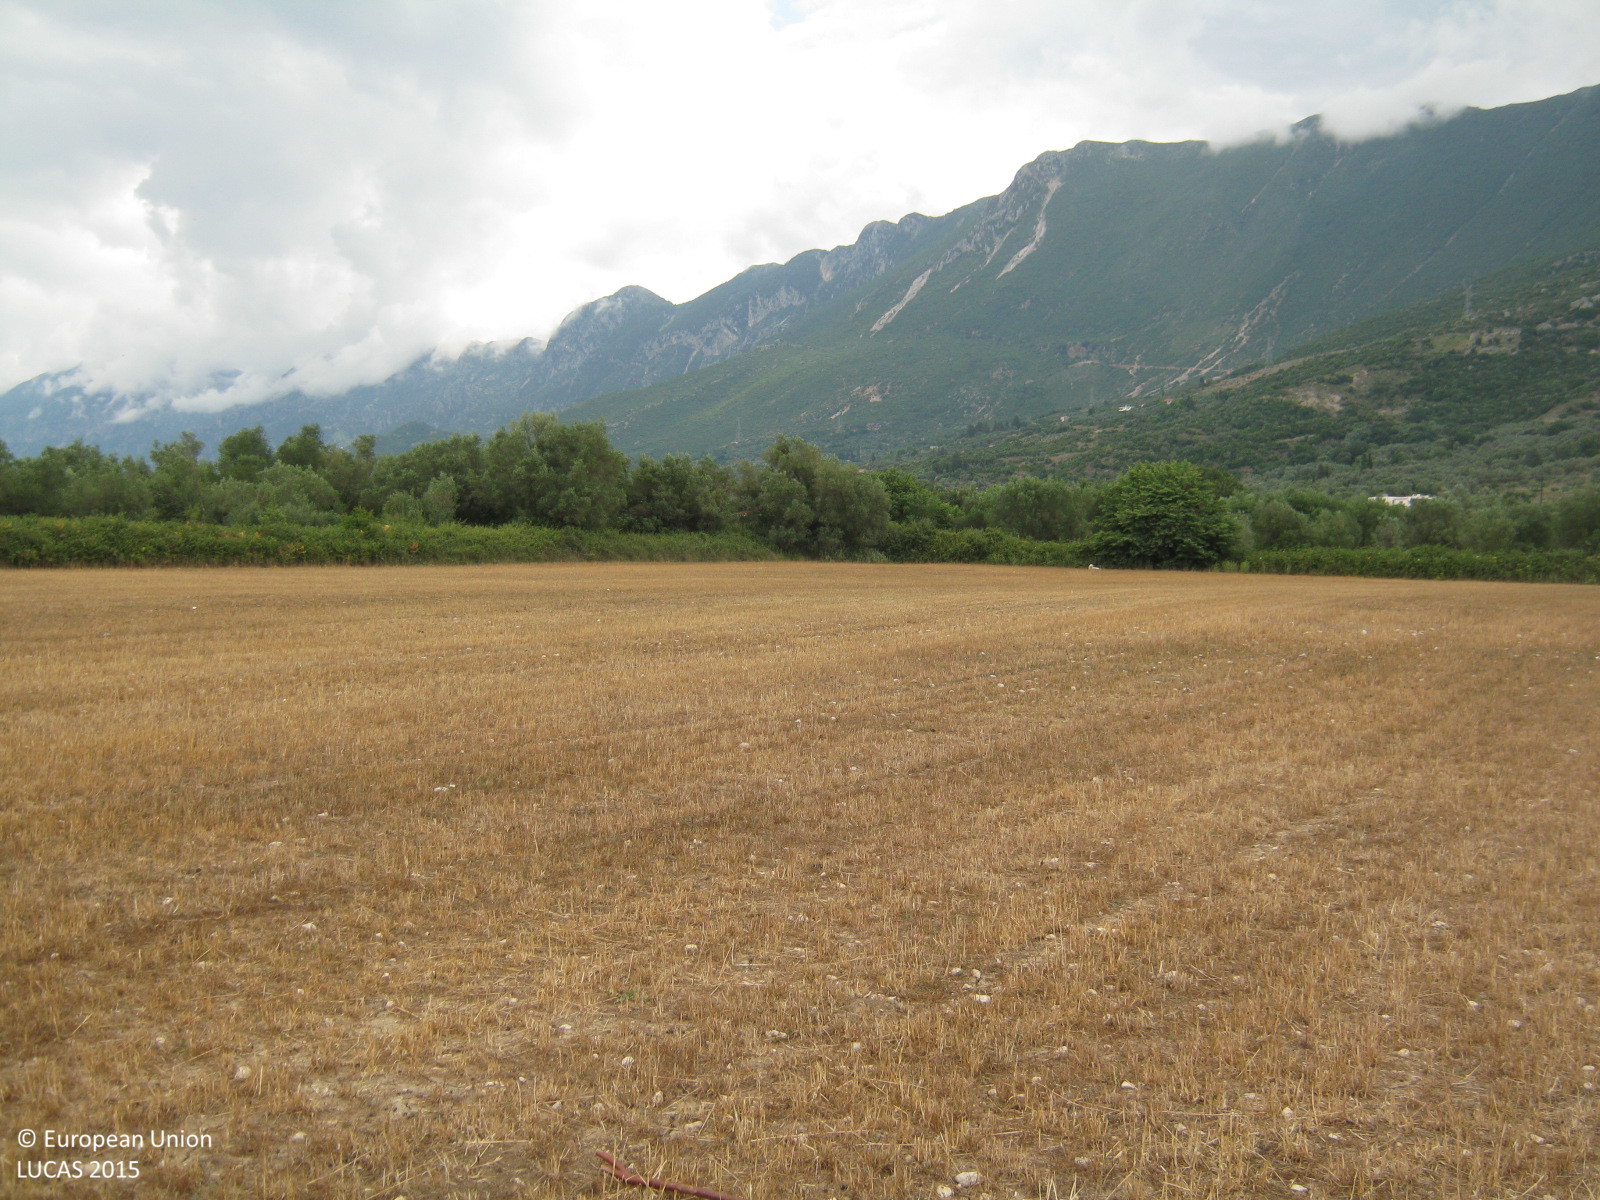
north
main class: Cropland
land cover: Common wheat
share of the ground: < 10 %
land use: Agriculture (excluding fallow land and kitchen gardens)
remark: Harvested field
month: June
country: GR
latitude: 39.3484
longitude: 20.5679
